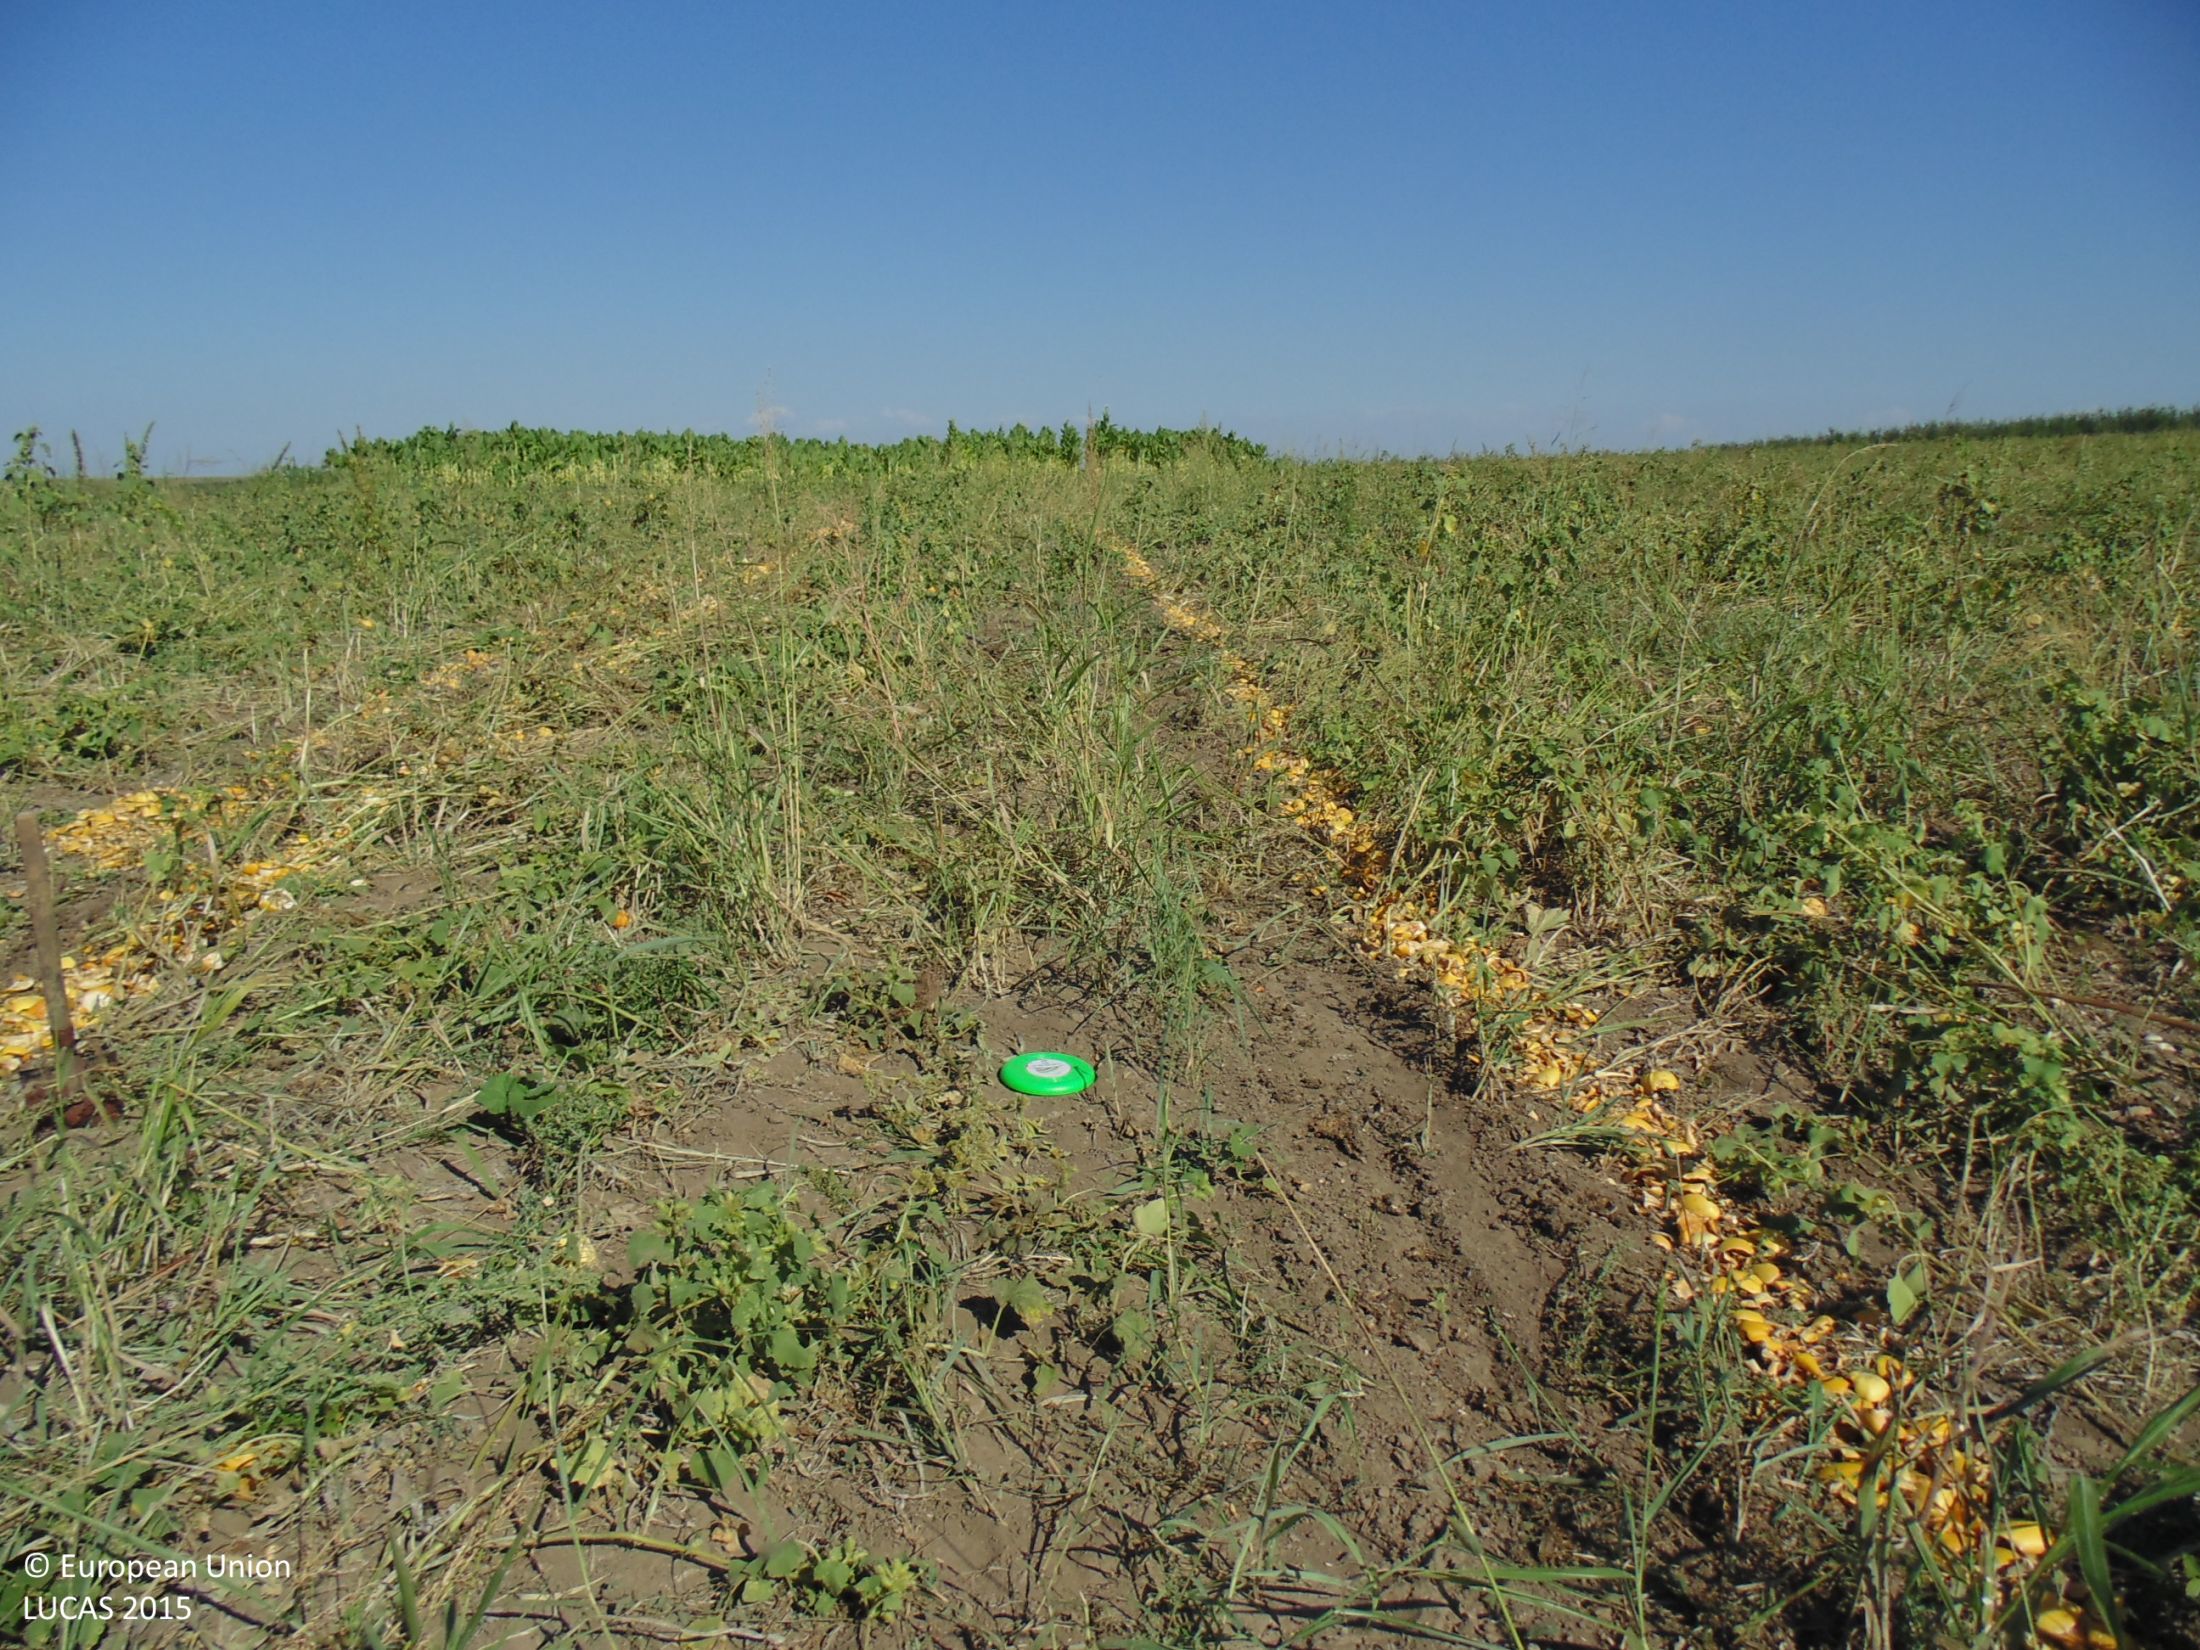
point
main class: Cropland
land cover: Other fresh vegetables
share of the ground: 10 - 25 %
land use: Agriculture (excluding fallow land and kitchen gardens)
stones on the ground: < 10 %
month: September
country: BG
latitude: 43.8804
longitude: 26.9601
